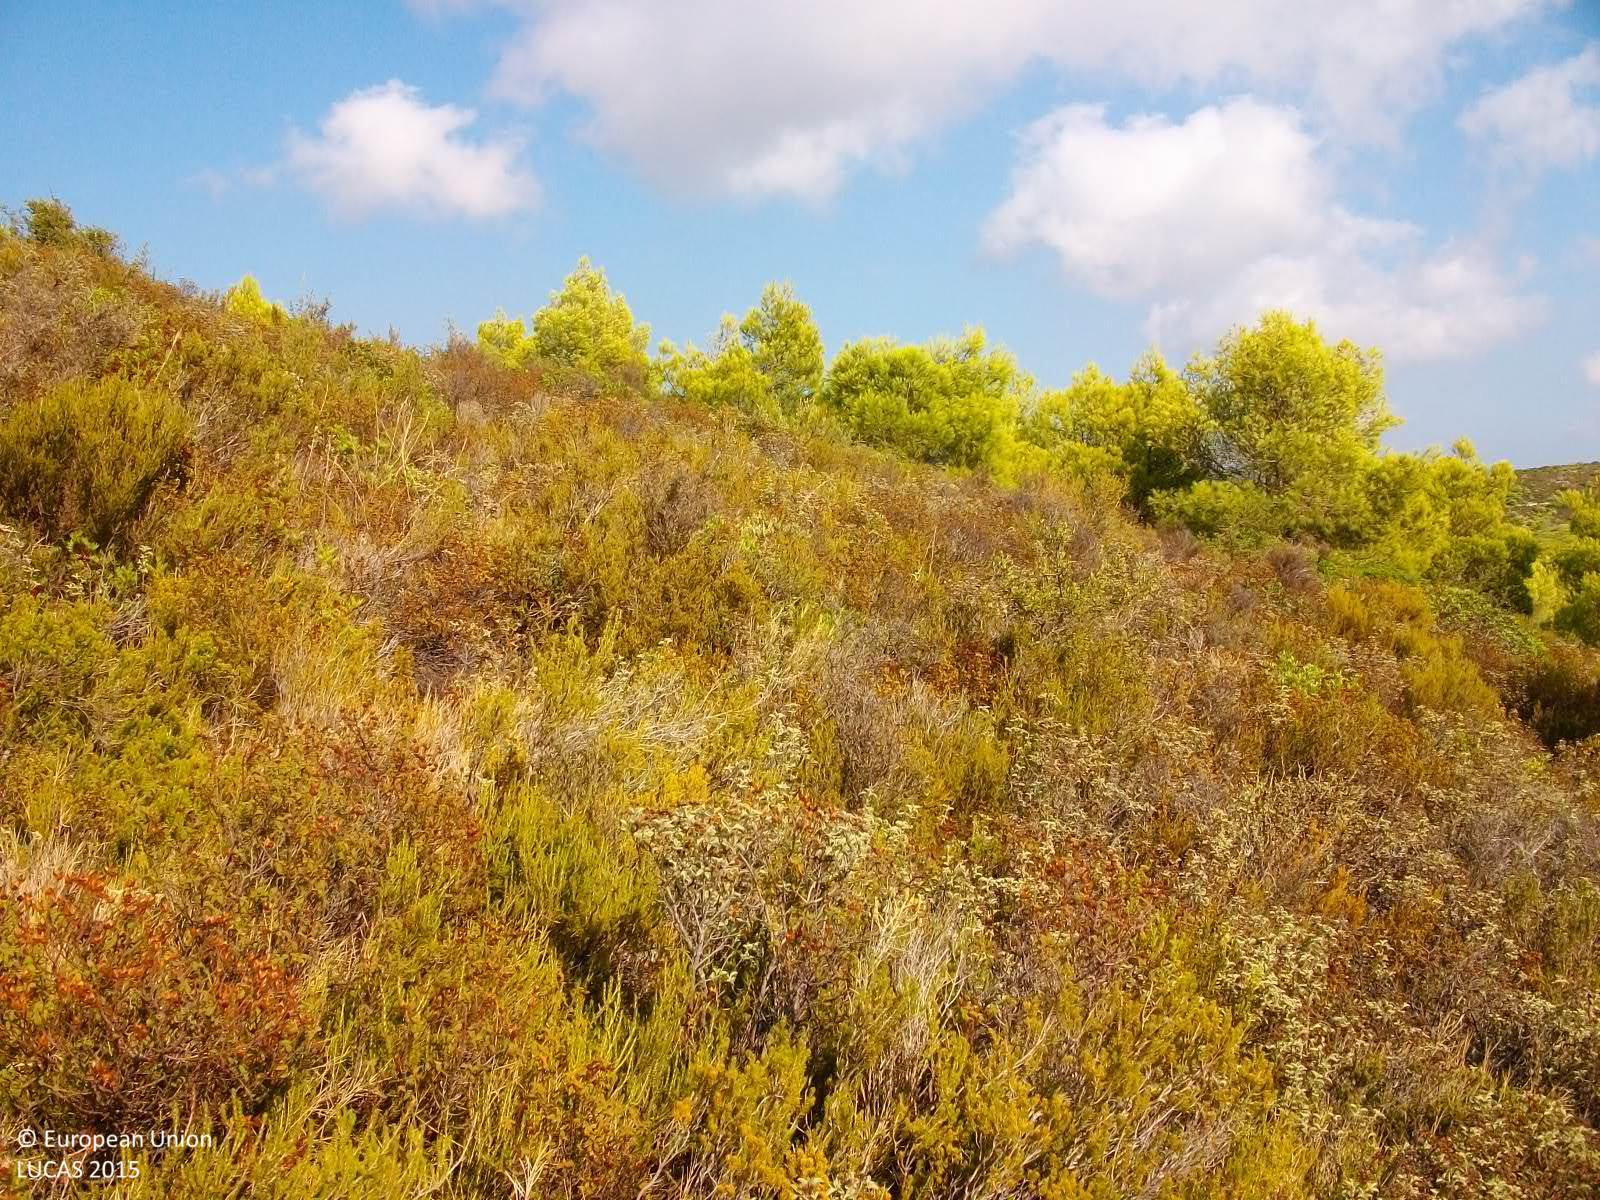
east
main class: Shrubland
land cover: Shrubland with sparse tree cover
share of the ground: > 75 %
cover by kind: shrubs 90 %, coniferous forest trees 5 %, consolidated bare surface 5 %
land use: Semi-natural and natural areas not in use
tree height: < 5 m
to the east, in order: Shrubland with sparse tree cover; Pine dominated coniferous woodland
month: September
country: GR
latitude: 37.8037
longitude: 20.6674
